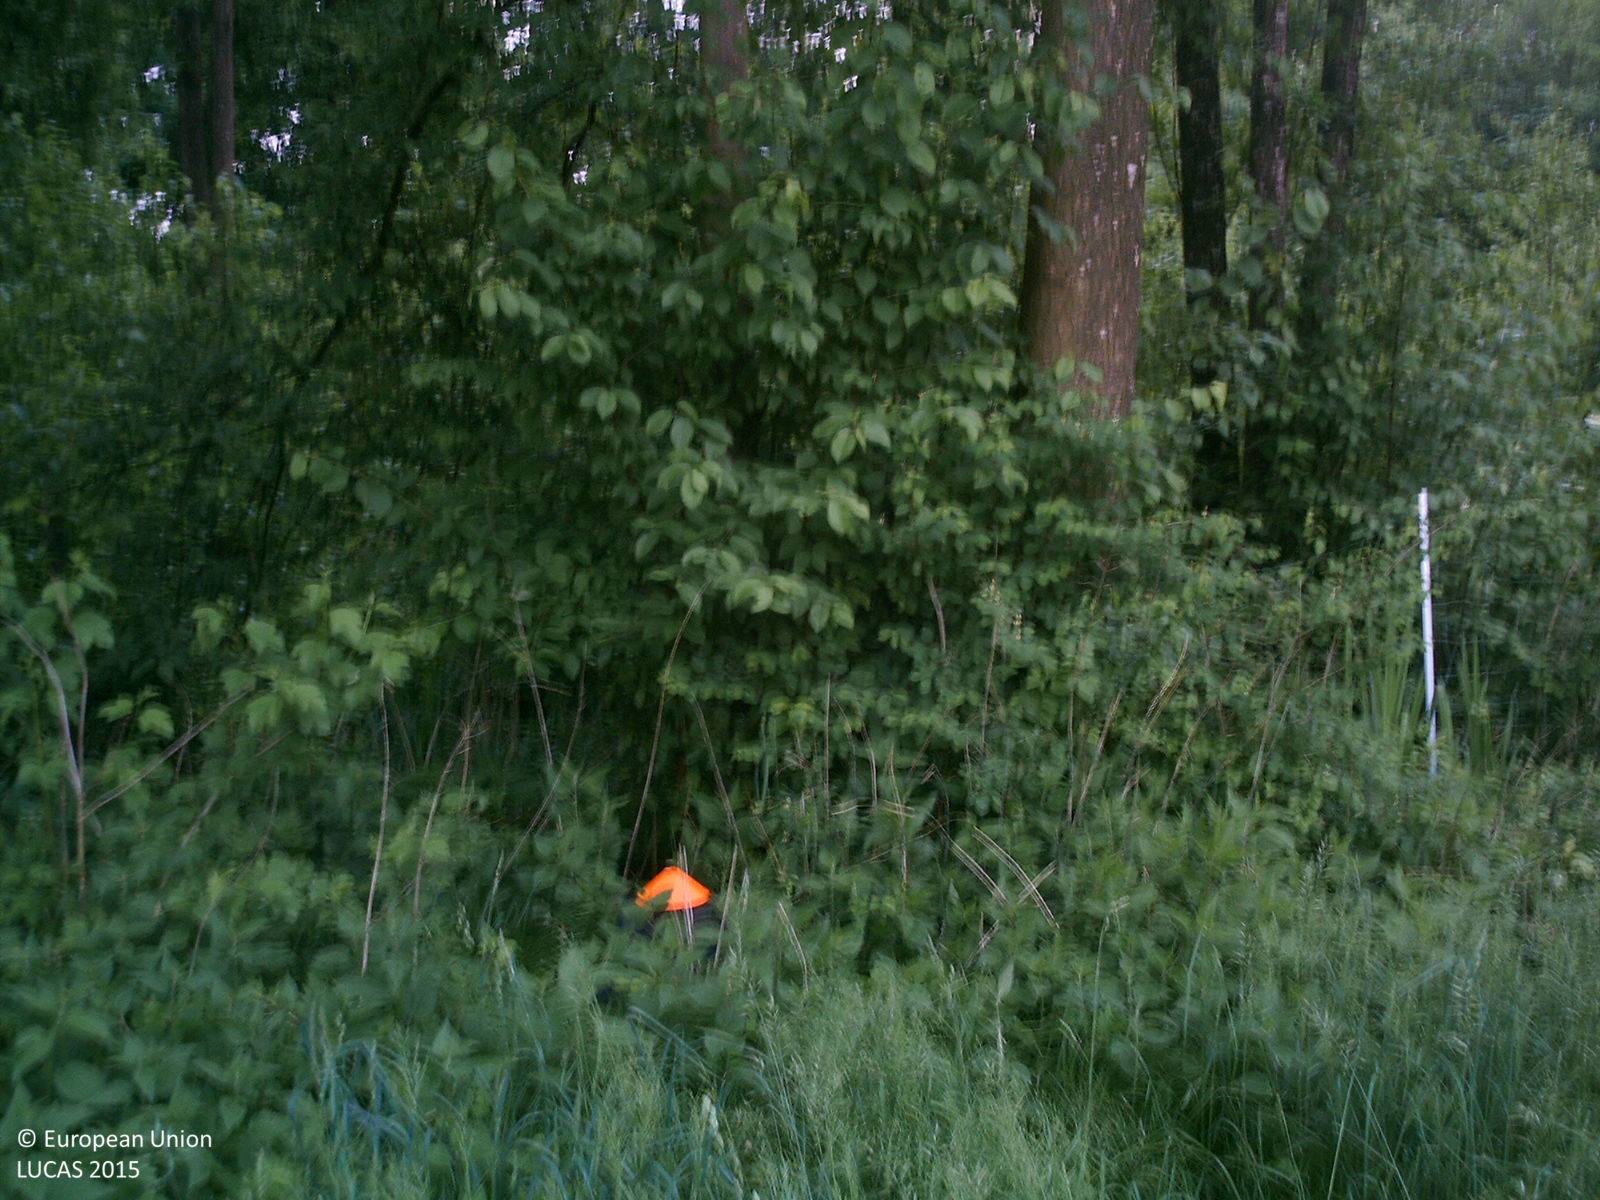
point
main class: Woodland
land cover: Broadleaved woodland
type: acidophilous oak and oak-birch forest
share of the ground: > 75 %
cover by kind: broadleaved forest trees 100 %
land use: Forestry
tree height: > 5 m
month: May
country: AT
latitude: 48.0755
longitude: 14.0934
